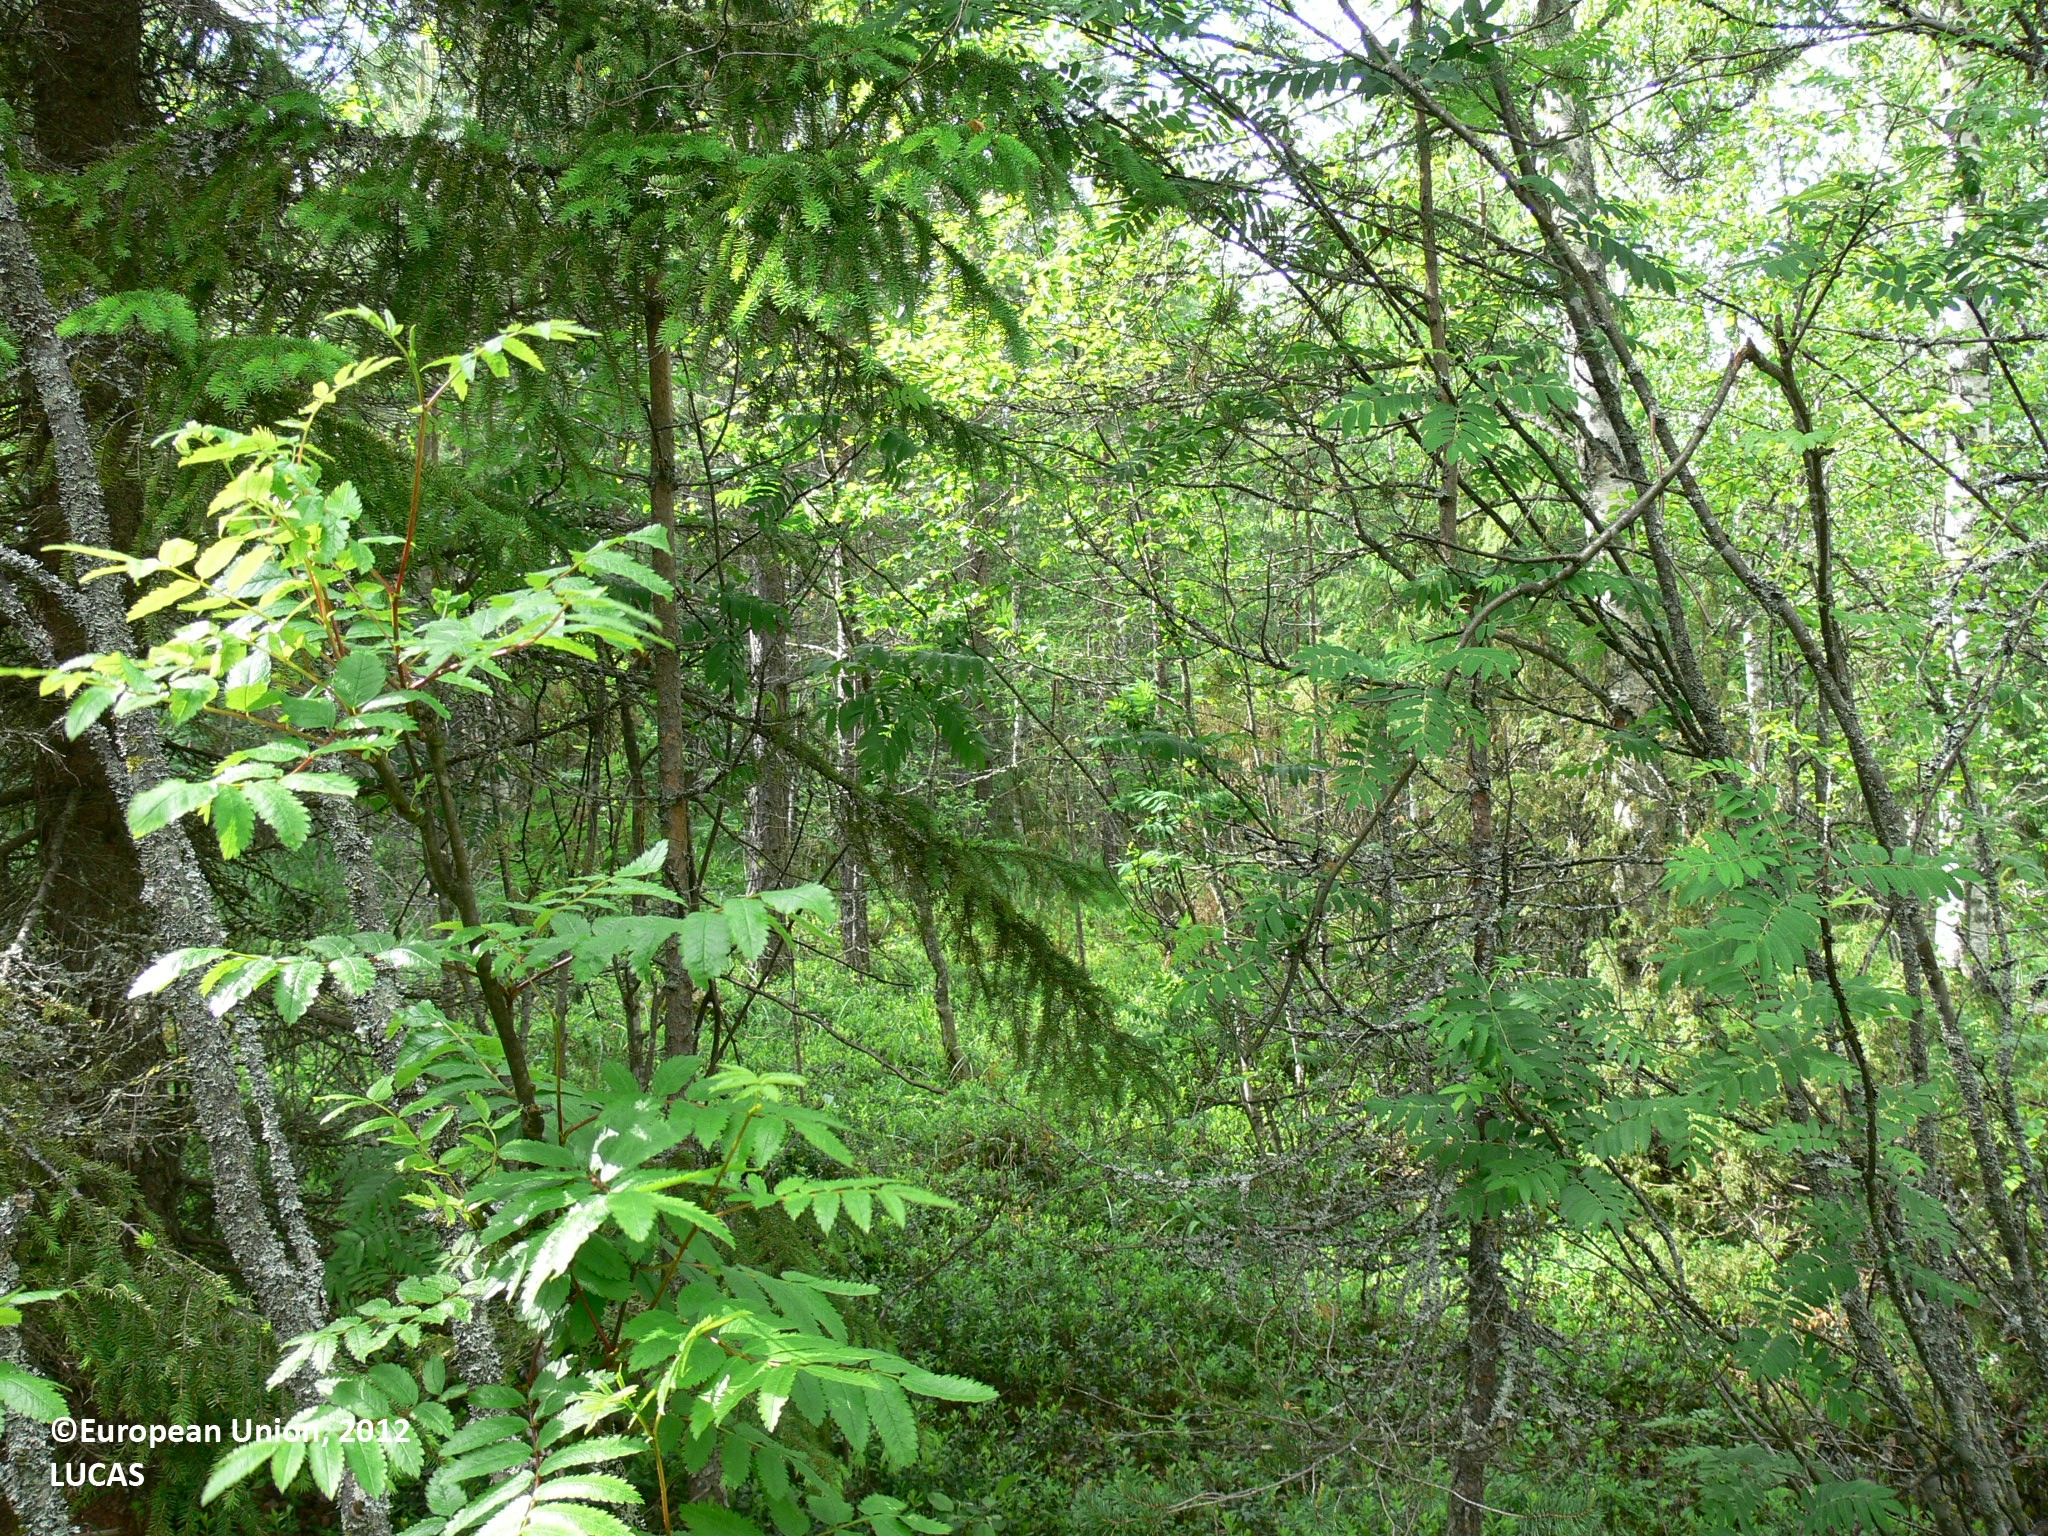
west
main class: Woodland
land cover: Other mixed woodland
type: boreal forest
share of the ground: 50 - 75 %
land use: Forestry
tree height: > 5 m
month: June
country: FI
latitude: 62.7340
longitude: 30.4908
